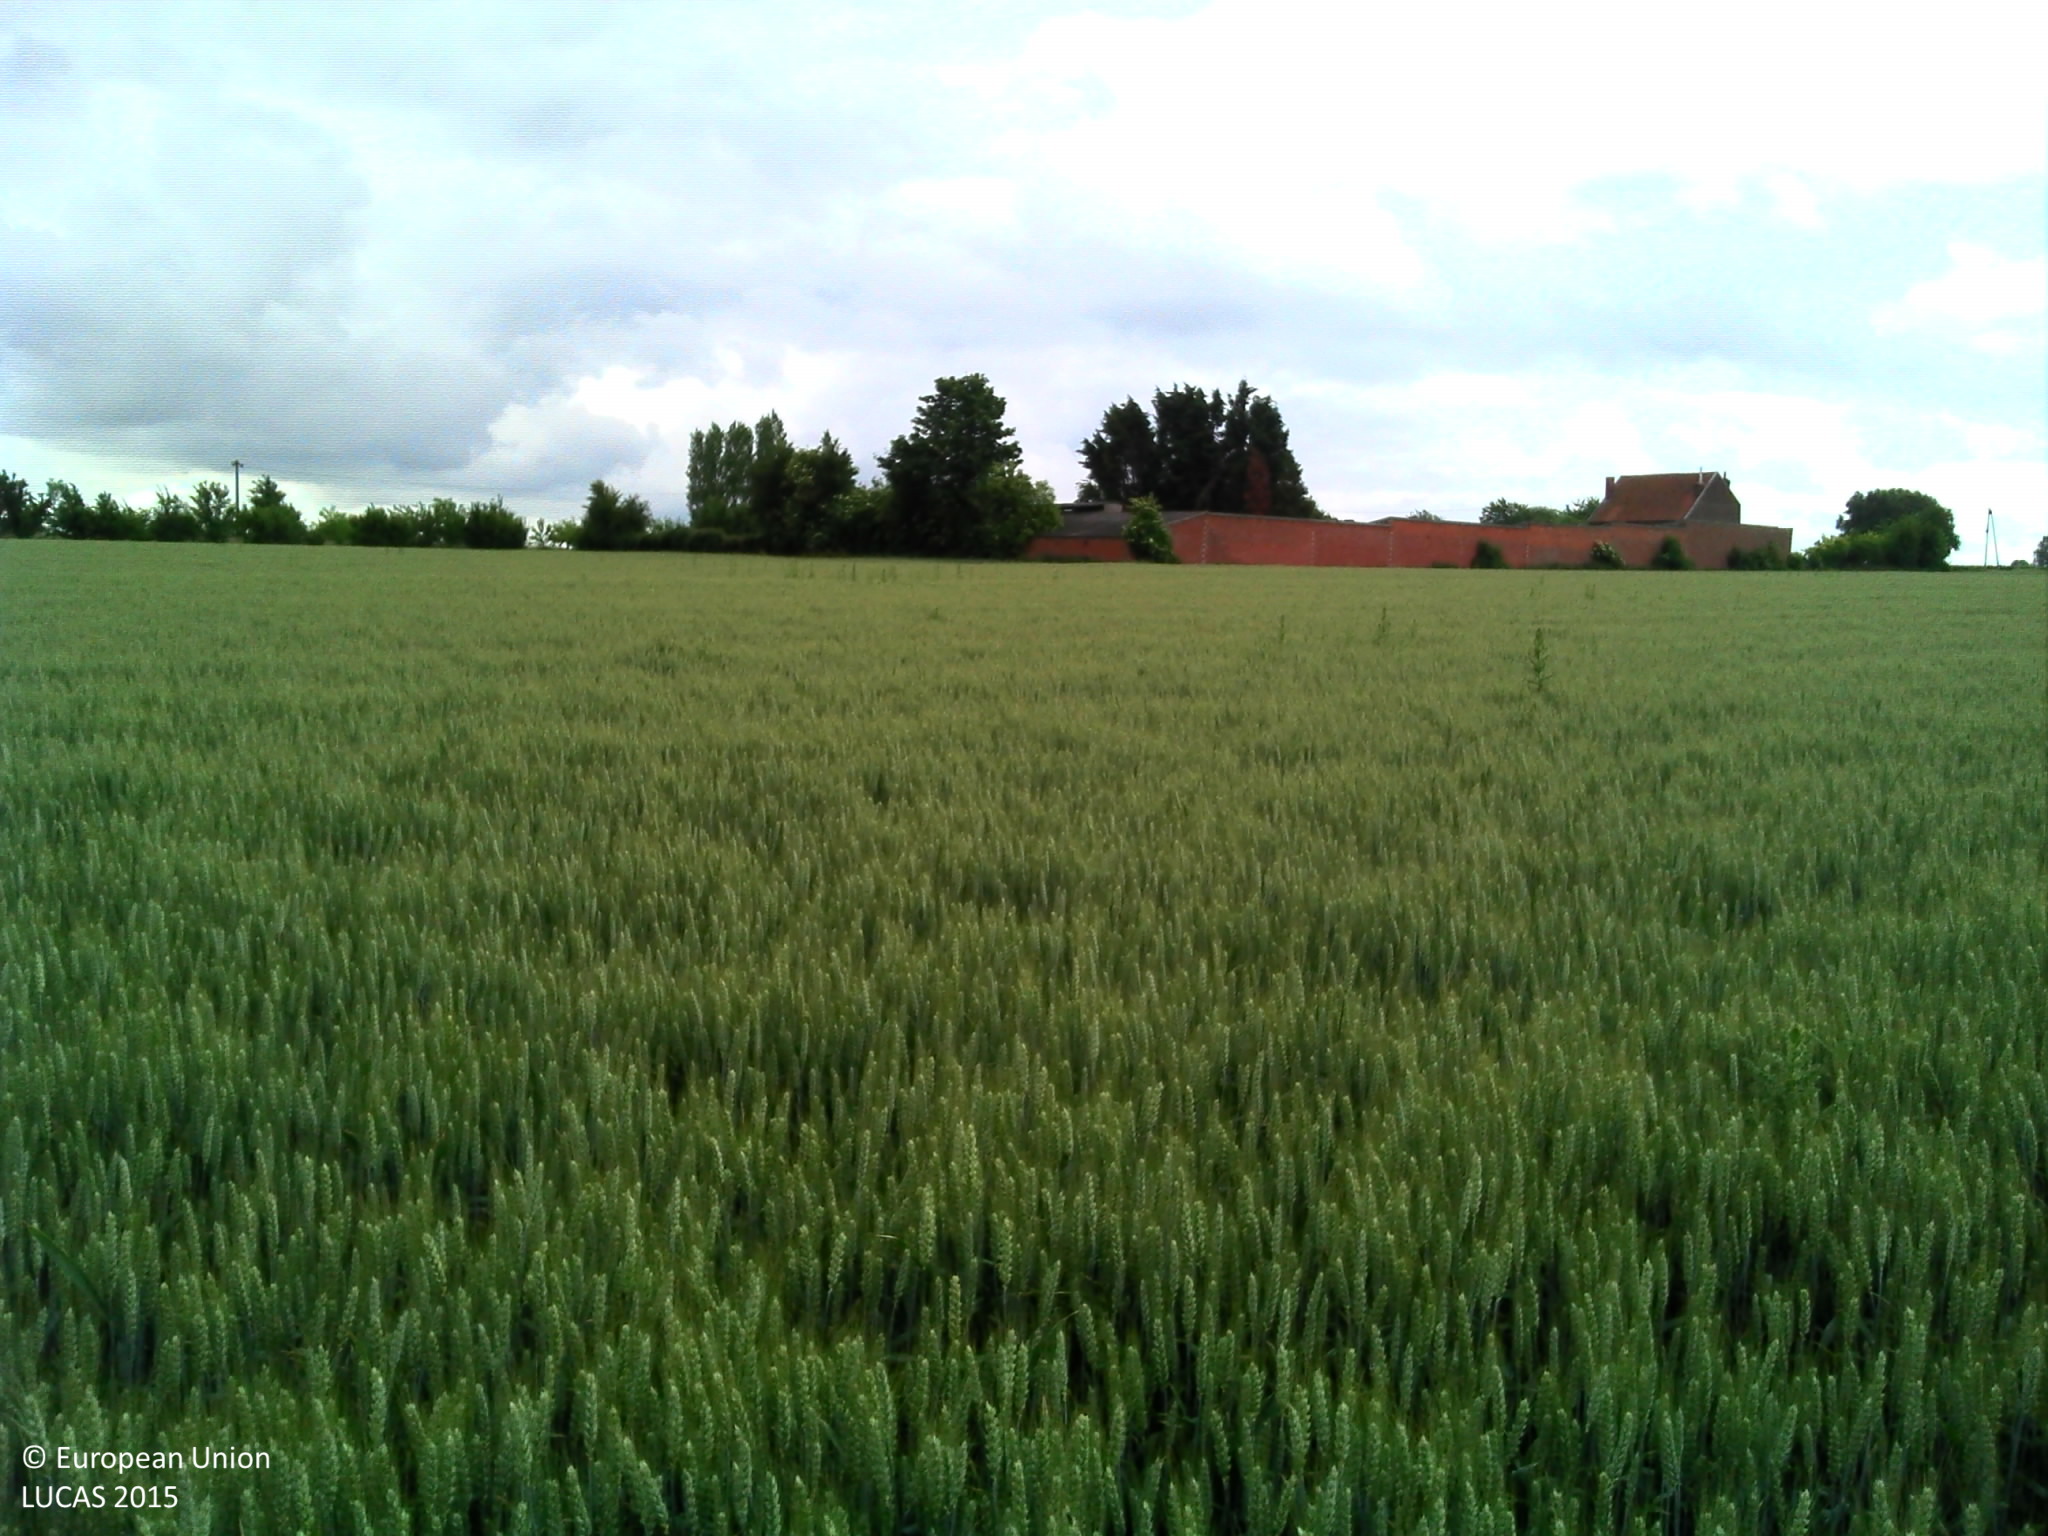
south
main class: Cropland
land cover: Common wheat
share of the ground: > 75 %
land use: Agriculture (excluding fallow land and kitchen gardens)
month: June
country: FR
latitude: 50.4952
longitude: 2.4736
